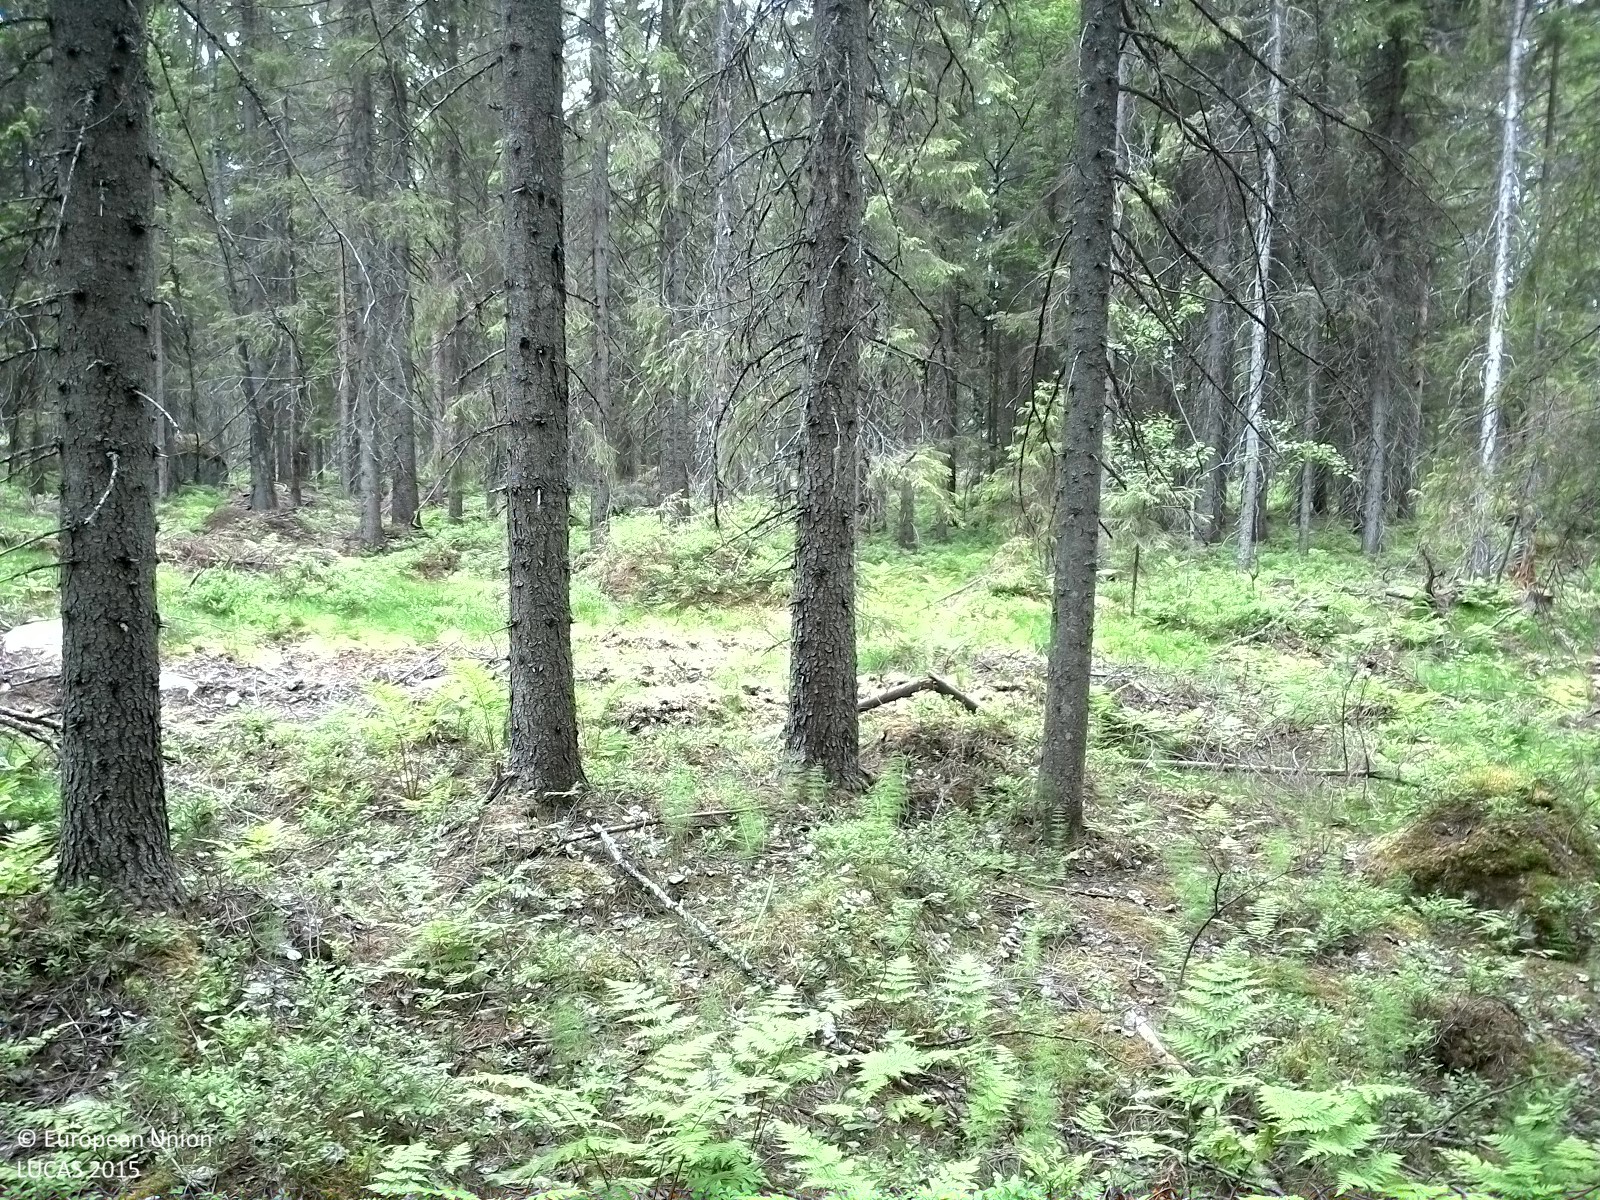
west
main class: Woodland
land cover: Spruce dominated coniferous woodland
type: boreal forest
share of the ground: 50 - 75 %
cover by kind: coniferous forest trees 50 %, shrubs 20 %, broadleaved forest trees 10 %, herbaceous plants 10 %, lichens and mosses 10 %
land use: Forestry
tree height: > 5 m
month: July
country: SE
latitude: 62.2212
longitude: 16.8471
